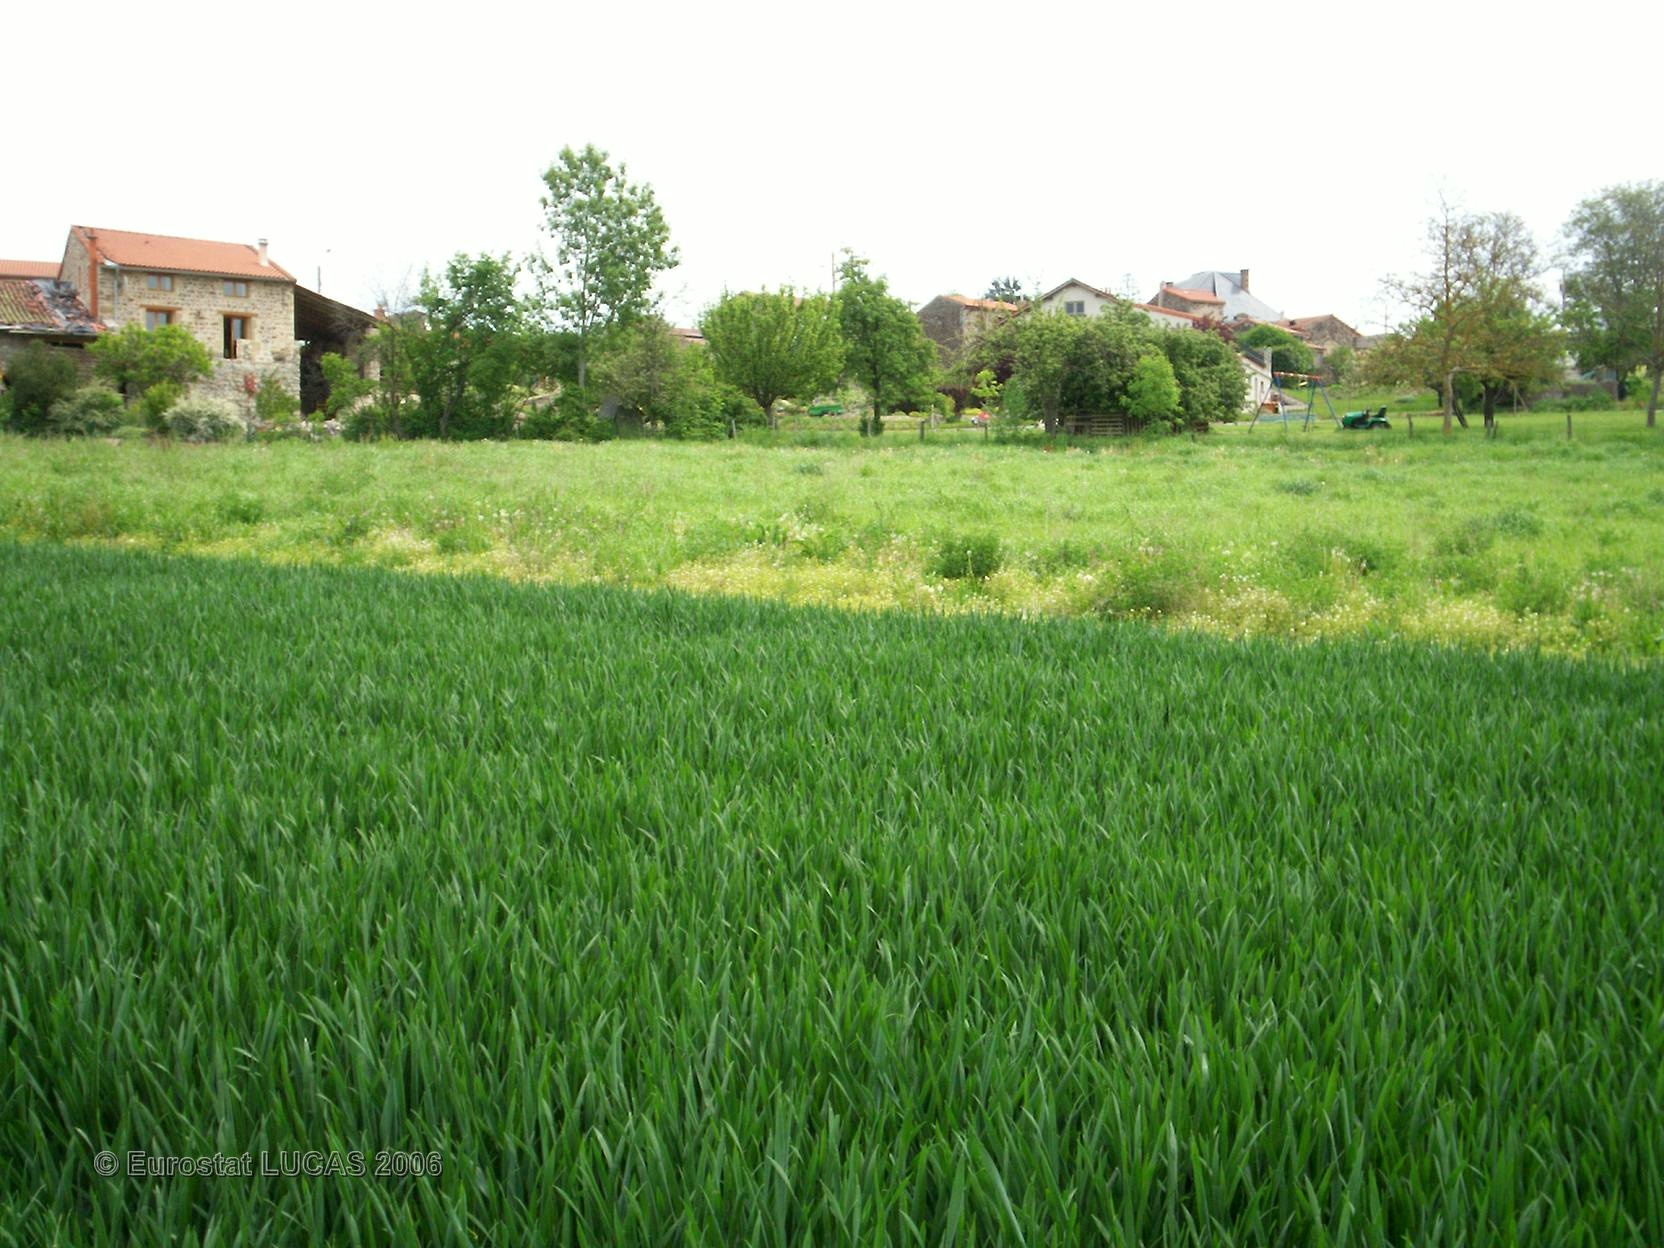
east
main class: Cropland
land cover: Common wheat
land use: Agriculture (excluding fallow land and kitchen gardens)
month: May
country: FR
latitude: 45.5986
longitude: 3.2961
